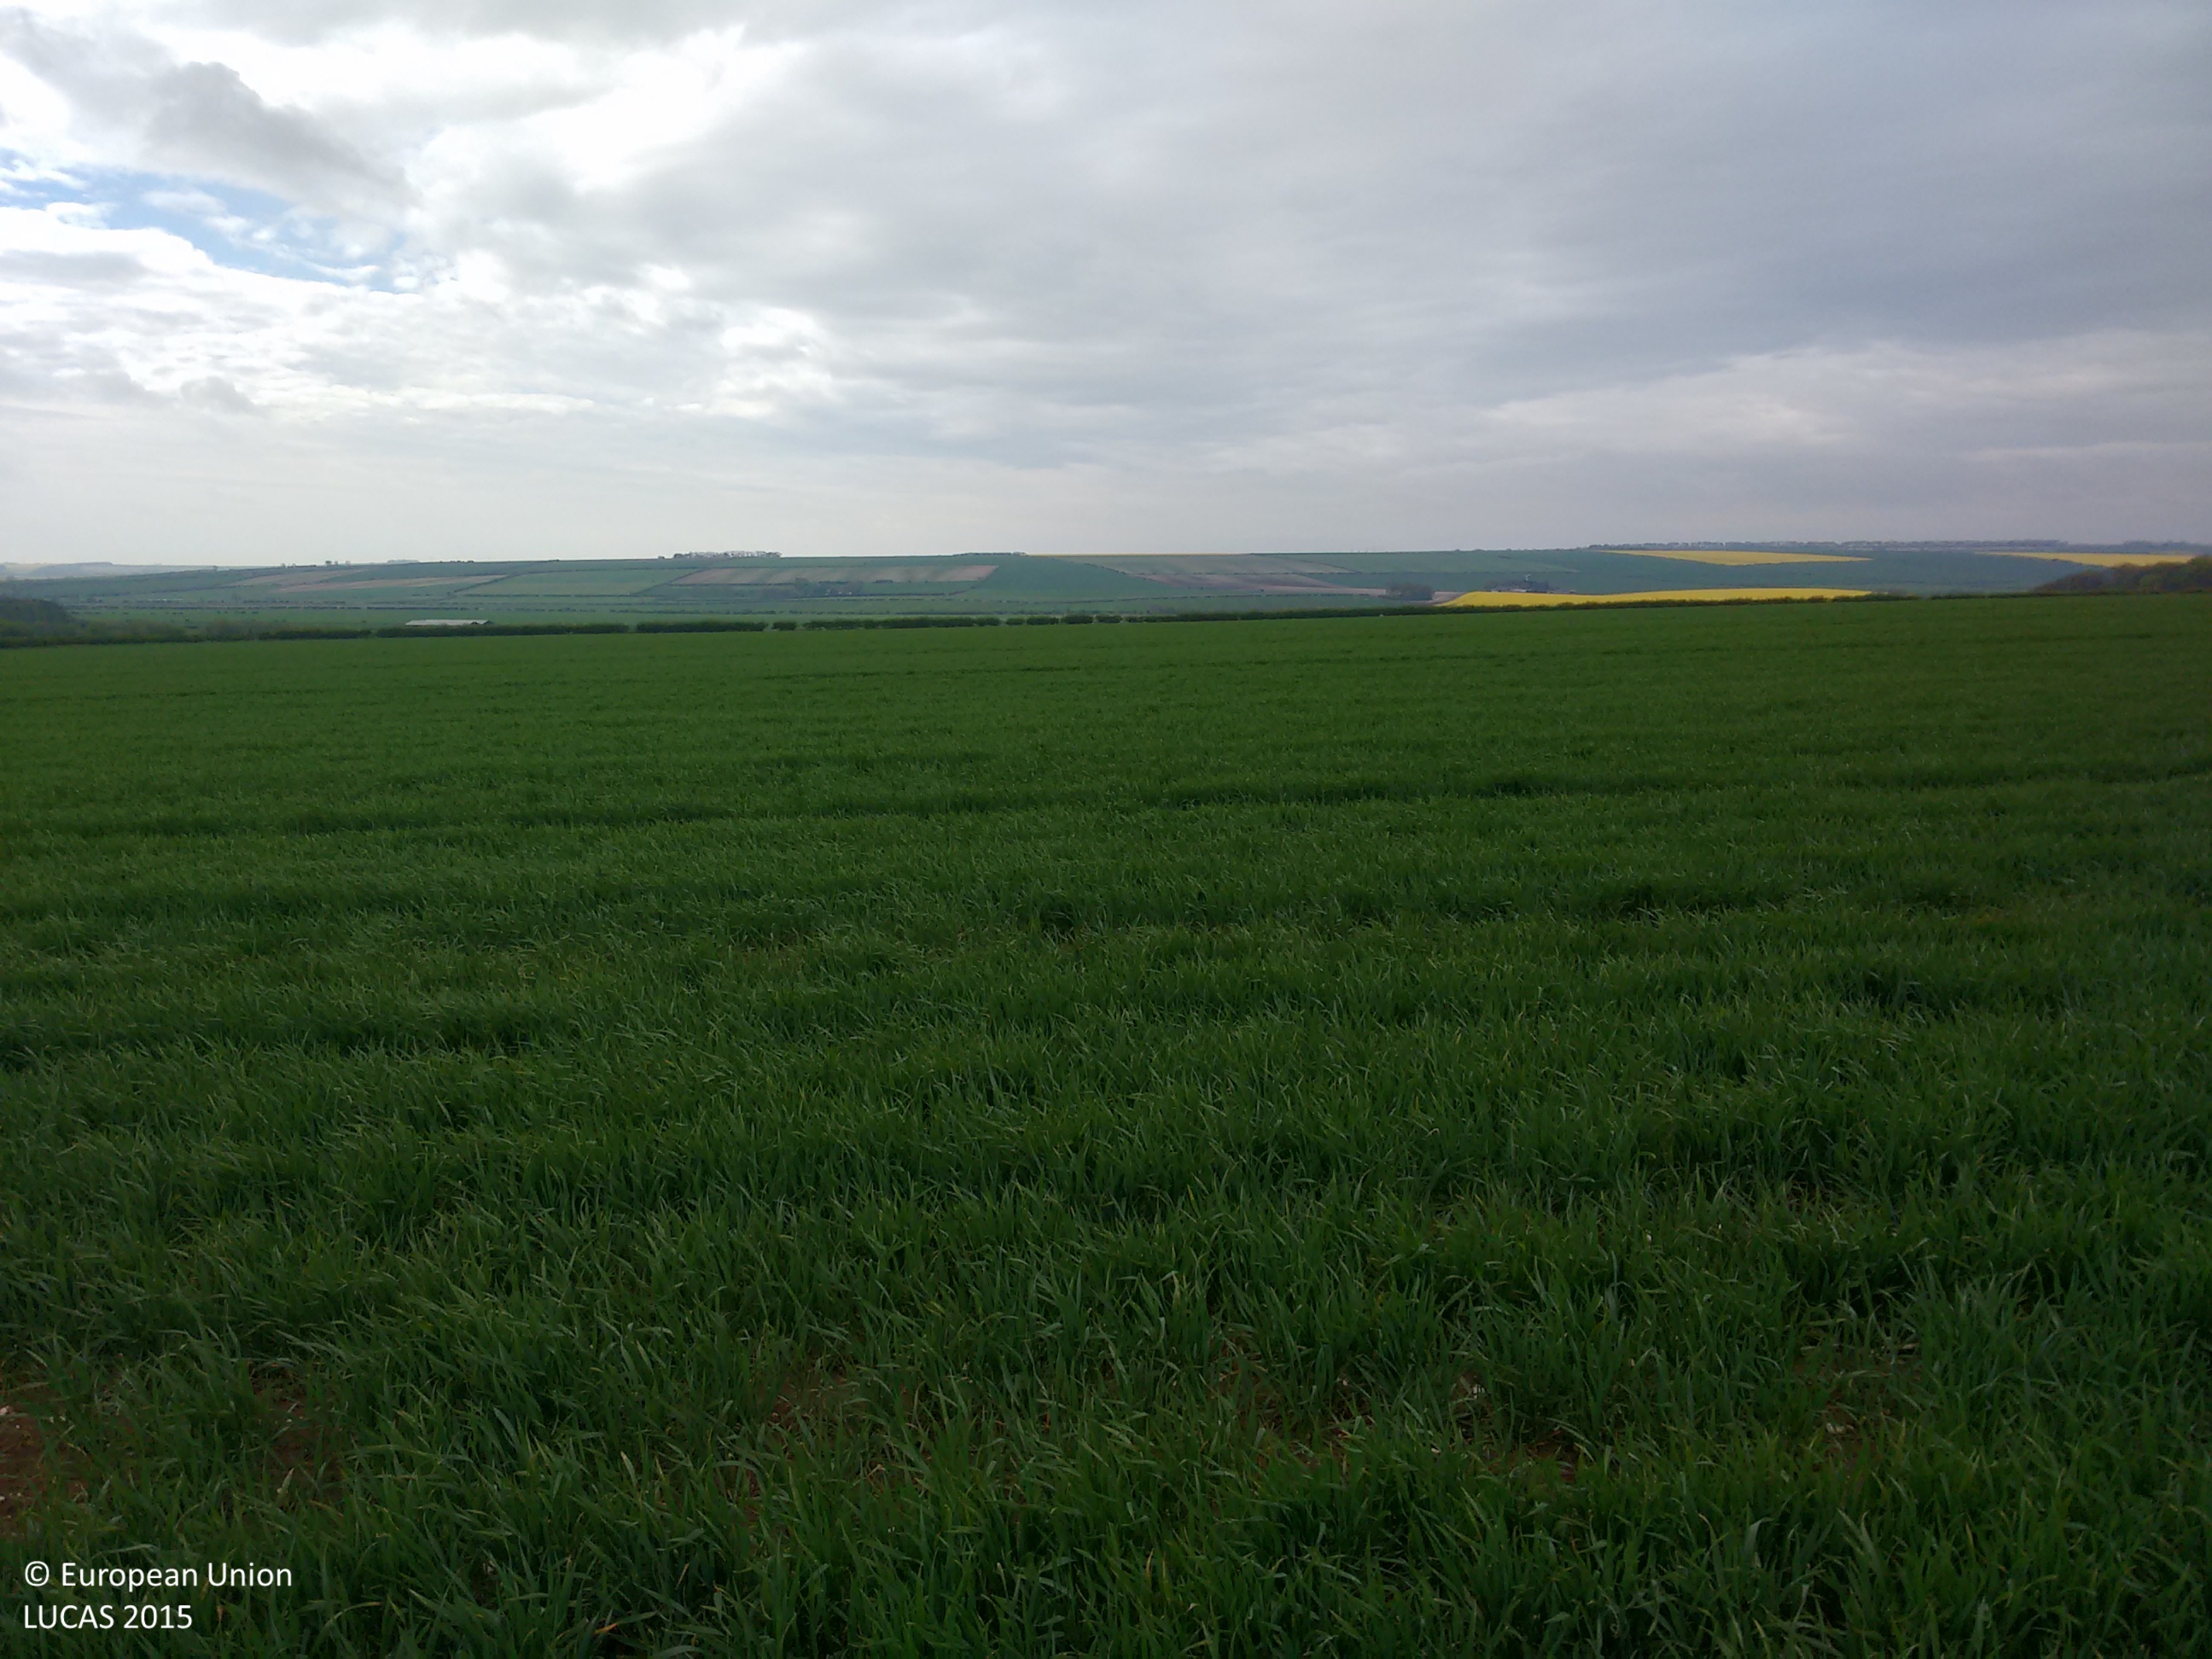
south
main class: Cropland
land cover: Common wheat
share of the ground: > 75 %
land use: Agriculture (excluding fallow land and kitchen gardens)
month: May
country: GB
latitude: 54.1523
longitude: -0.3701
